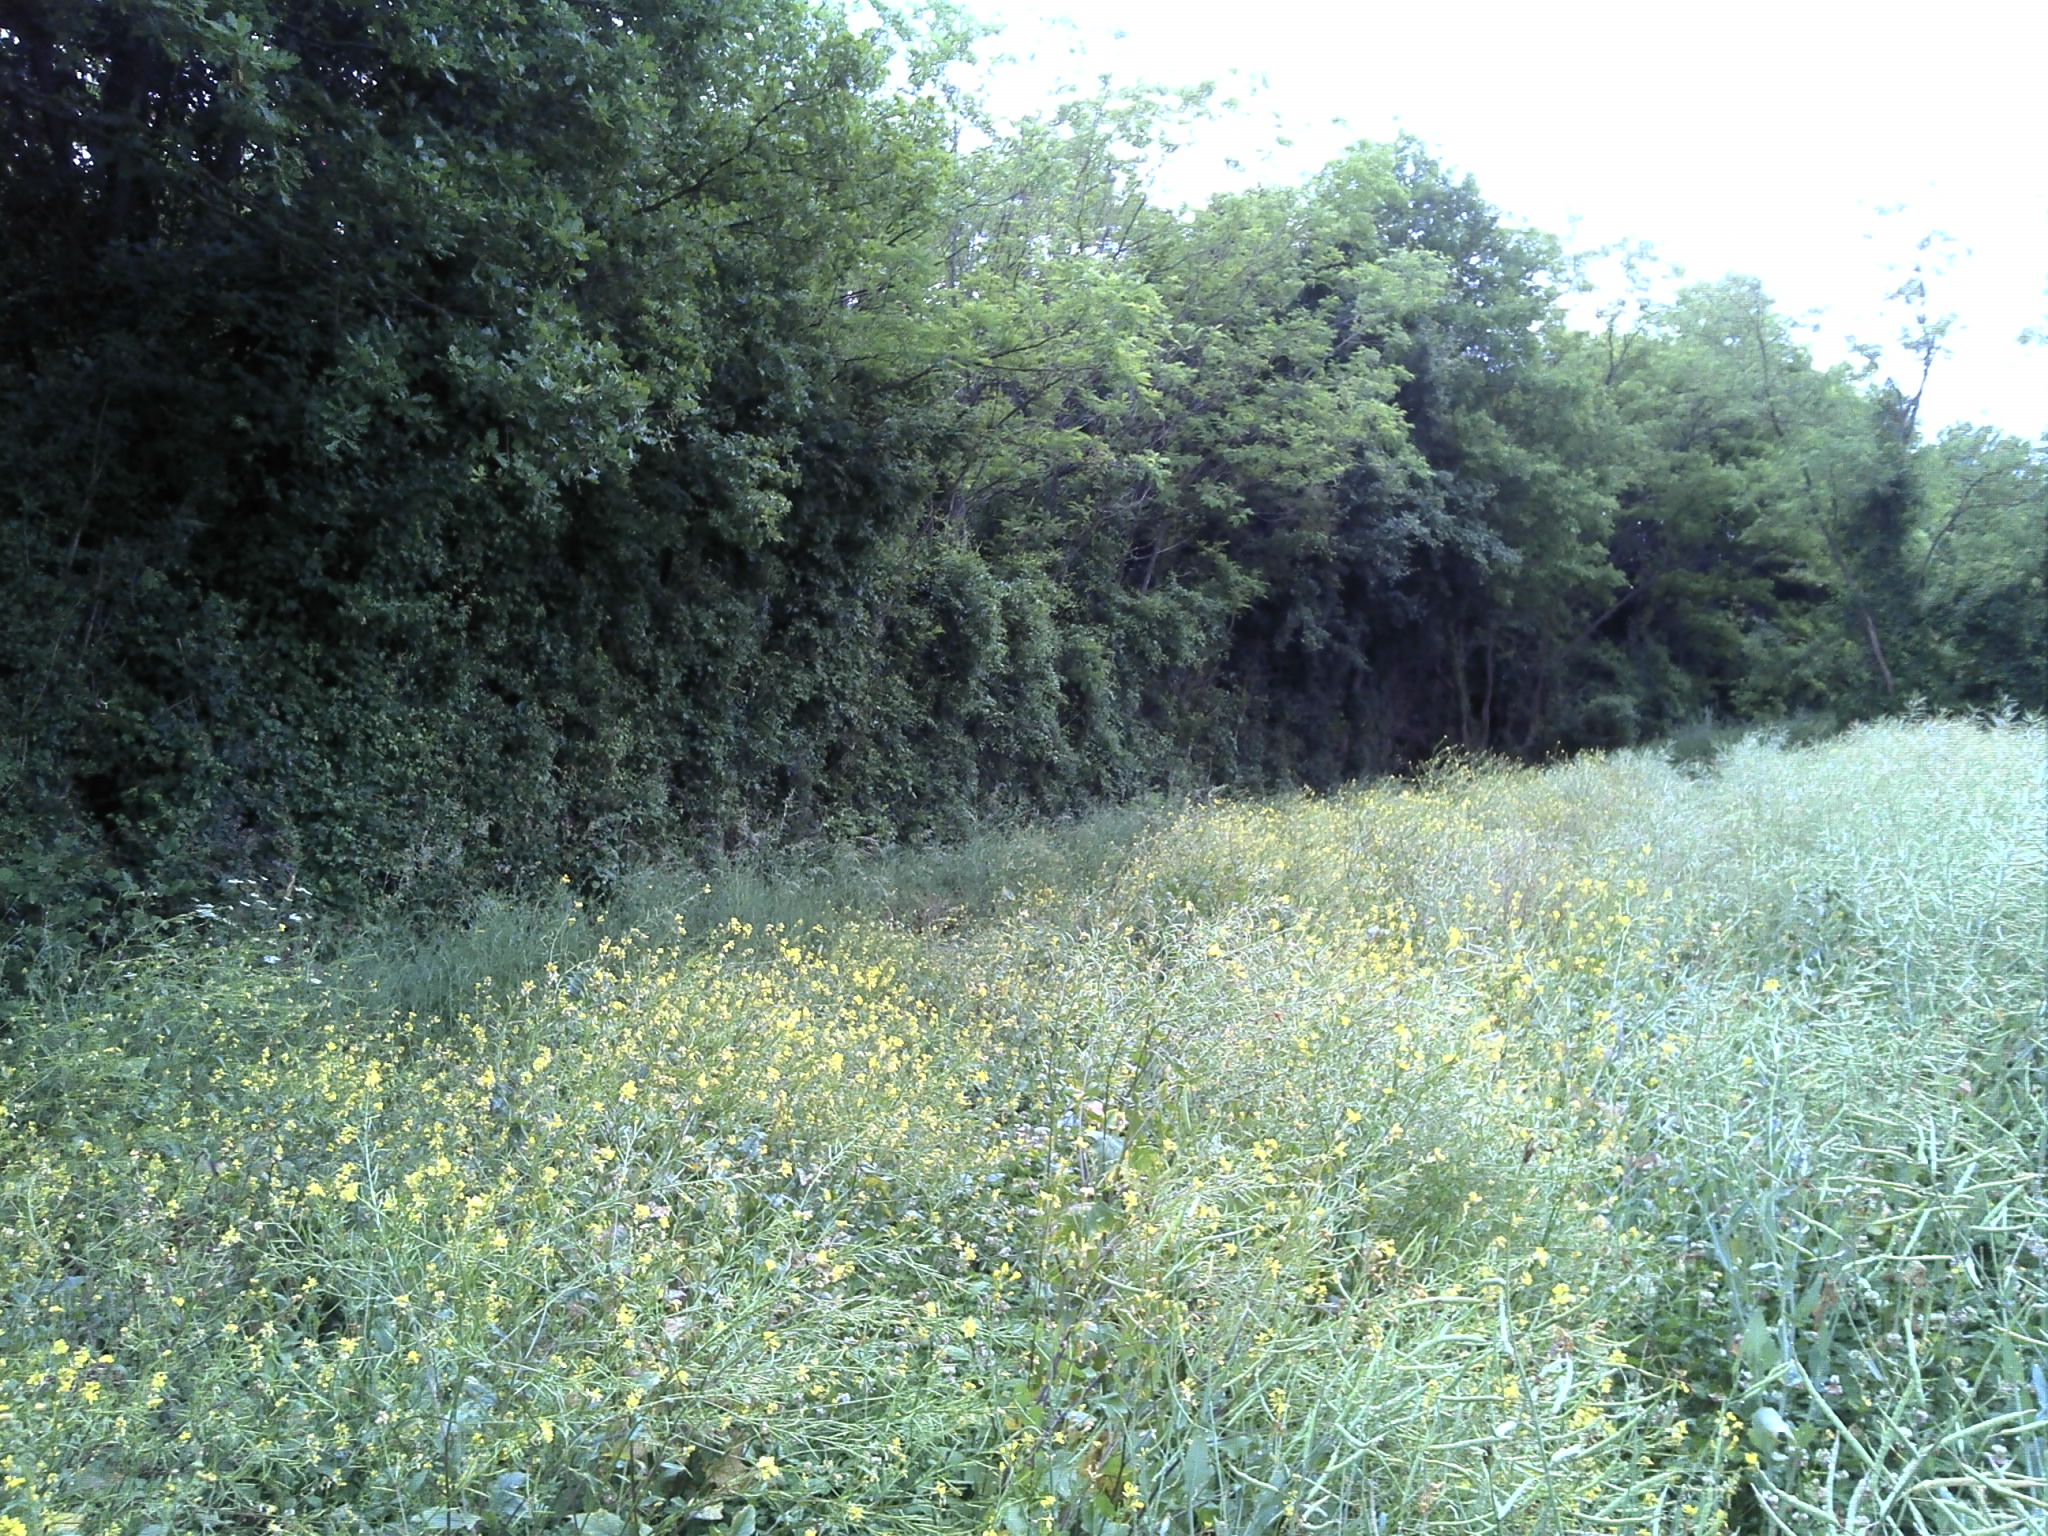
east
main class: Cropland
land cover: Rape and turnip rape
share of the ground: > 75 %
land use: Agriculture (excluding fallow land and kitchen gardens)
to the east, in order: Rape and turnip rape; Broadleaved woodland; Grassland without tree/shrub cover; Electric lines; Grassland without tree/shrub cover; Broadleaved woodland; Grassland without tree/shrub cover; Broadleaved woodland; Grassland without tree/shrub cover; Electric lines; Grassland without tree/shrub cover; Broadleaved woodland
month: June
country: FR
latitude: 46.6290
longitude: 1.5126
